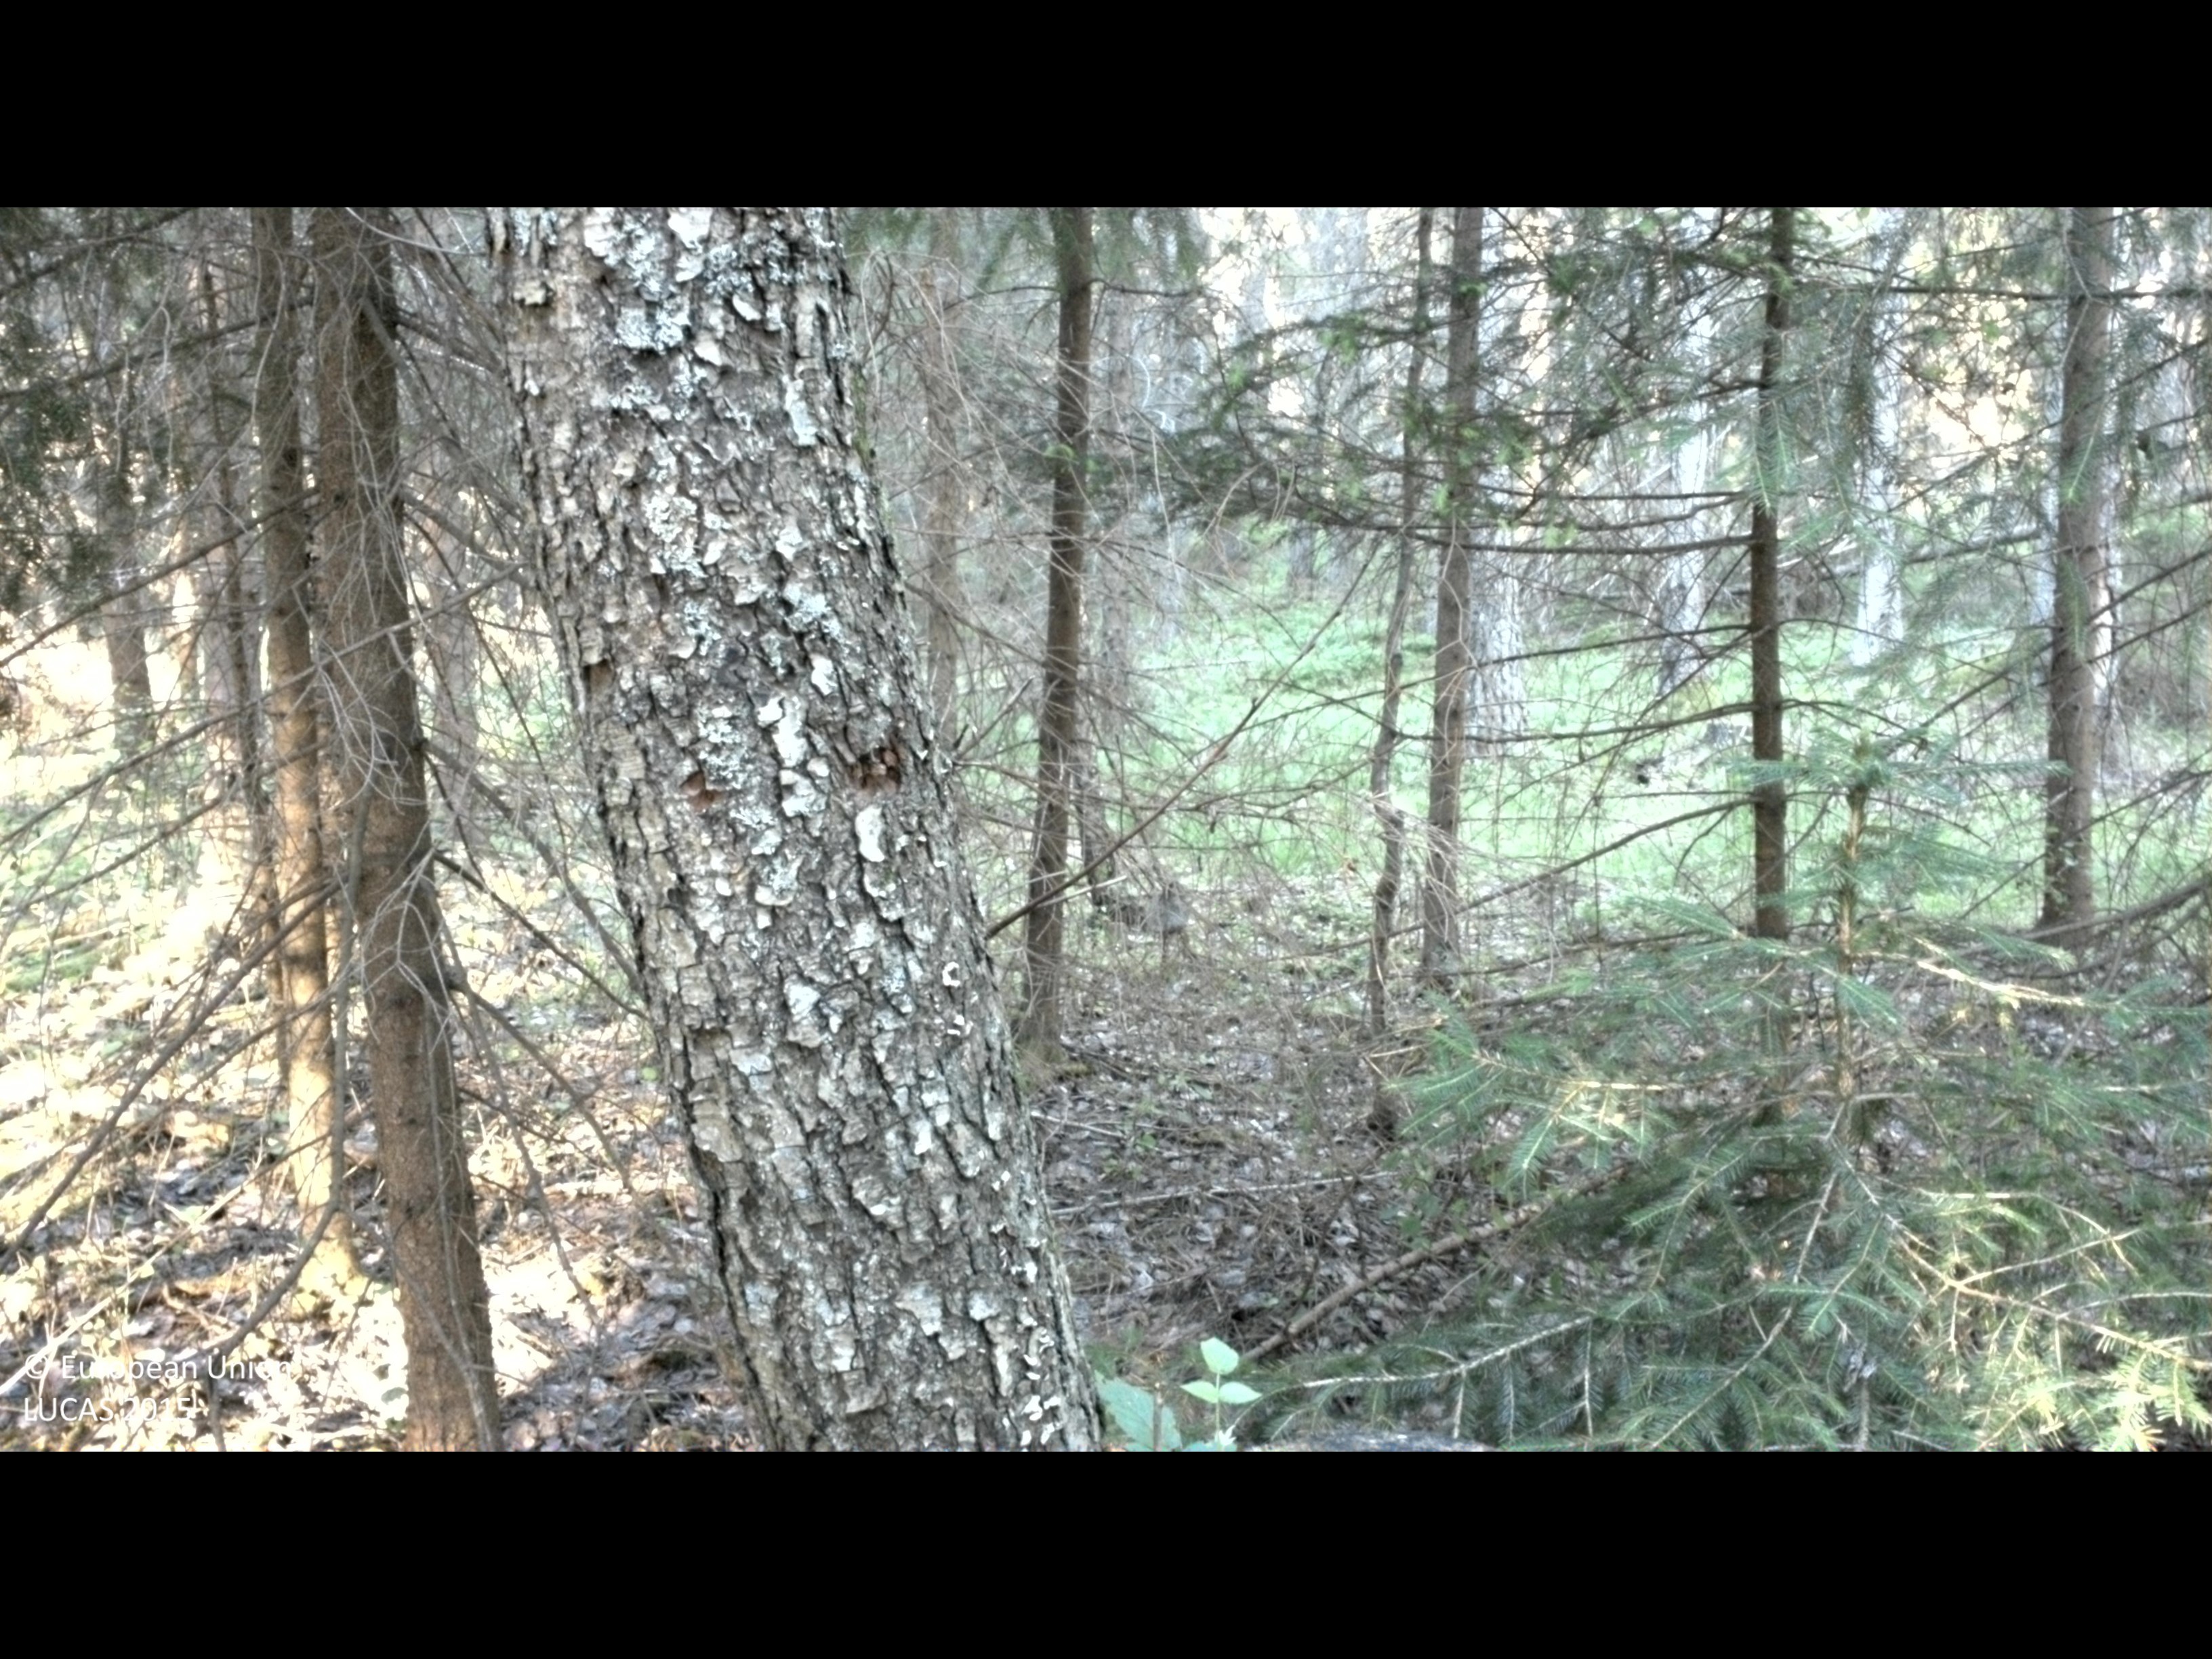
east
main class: Woodland
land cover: Spruce dominated coniferous woodland
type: boreal forest
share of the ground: > 75 %
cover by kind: coniferous forest trees 65 %, broadleaved forest trees 15 %, herbaceous plants 10 %, shrubs 5 %, lichens and mosses 5 %
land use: Forestry
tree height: > 5 m
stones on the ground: < 10 %
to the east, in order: Spruce dominated coniferous woodland; Other coniferous woodland; Pine dominated coniferous woodland; Spruce dominated coniferous woodland; Tracks; Other mixed woodland; Ditches and canals; Spruce dominated coniferous woodland
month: July
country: SE
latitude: 58.1943
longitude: 16.7514
